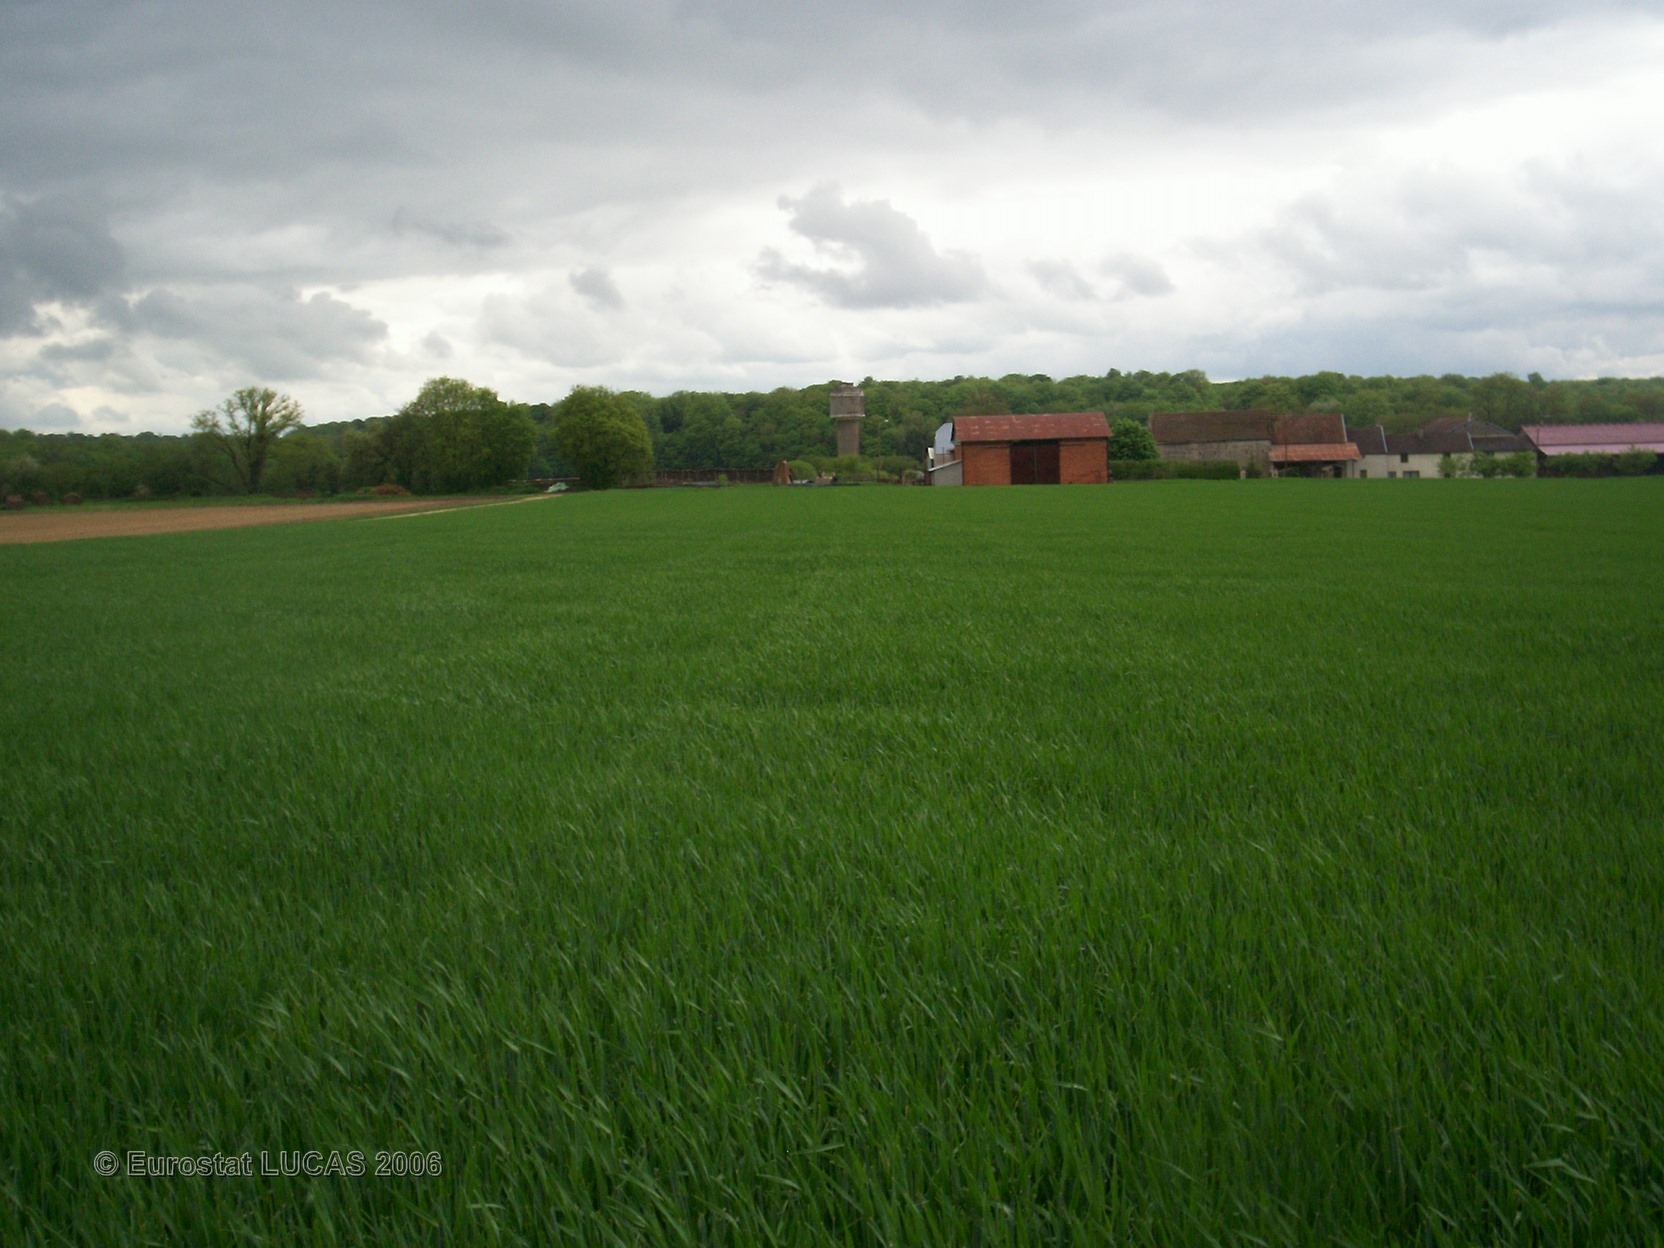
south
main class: Cropland
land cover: Barley
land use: Agriculture (excluding fallow land and kitchen gardens)
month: May
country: FR
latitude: 47.7677
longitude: 4.6216
